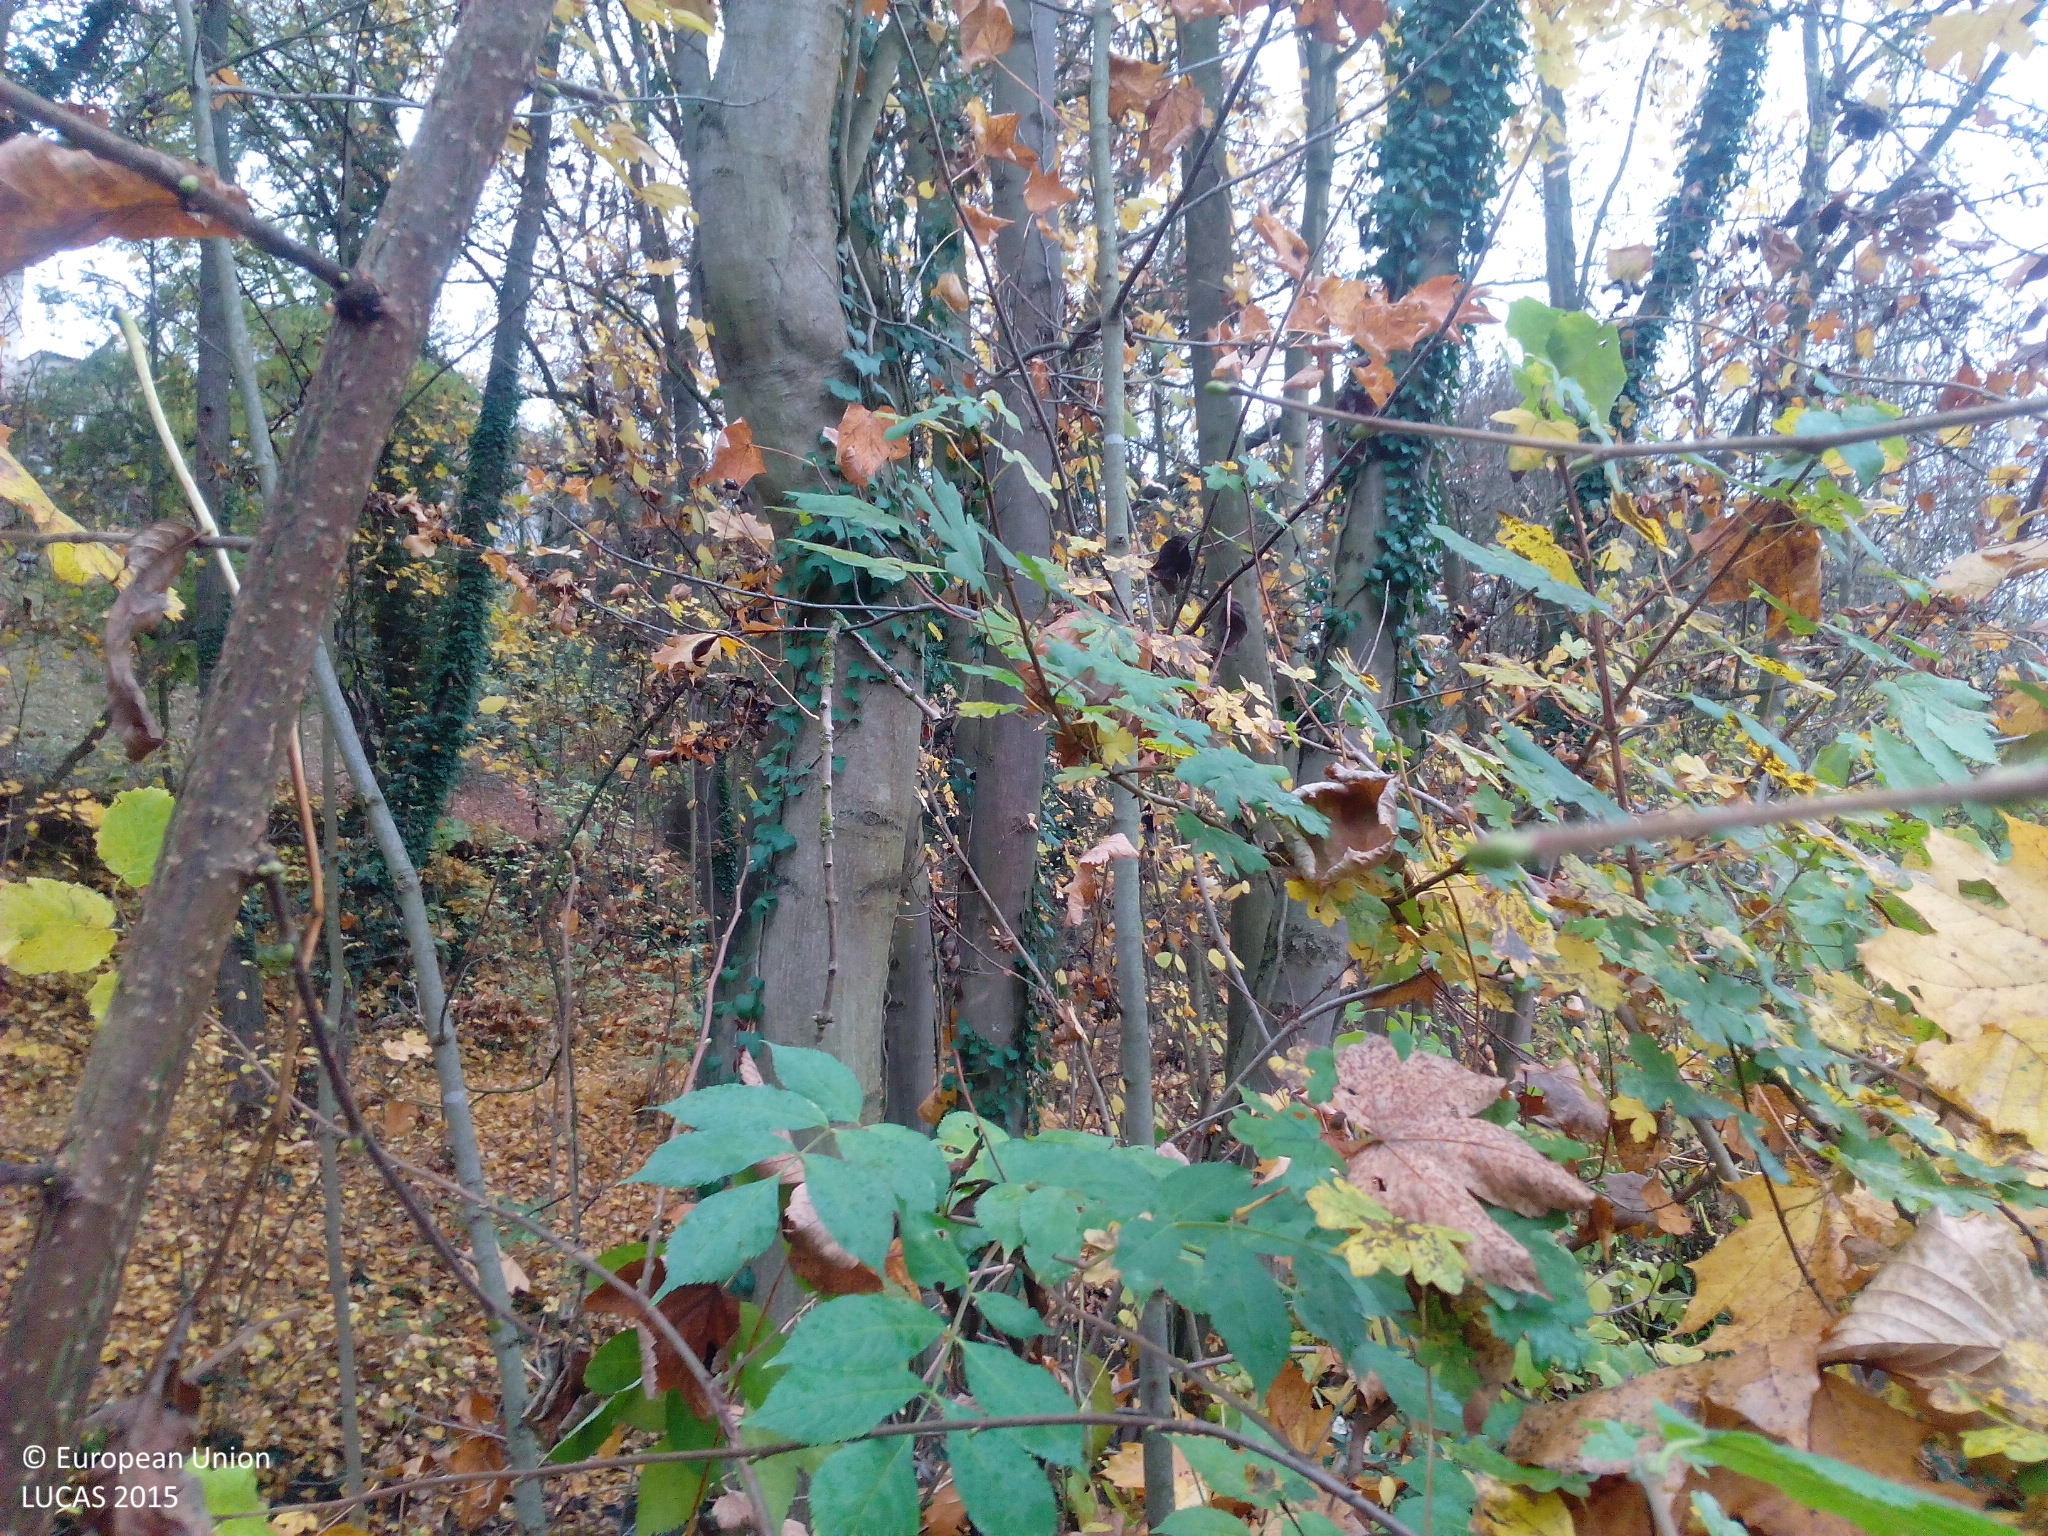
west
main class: Woodland
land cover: Broadleaved woodland
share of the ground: > 75 %
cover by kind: broadleaved forest trees 85 %, herbaceous plants 10 %, shrubs 5 %
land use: Community services
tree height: > 5 m
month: May
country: DE
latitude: 49.0842
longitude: 9.1925
